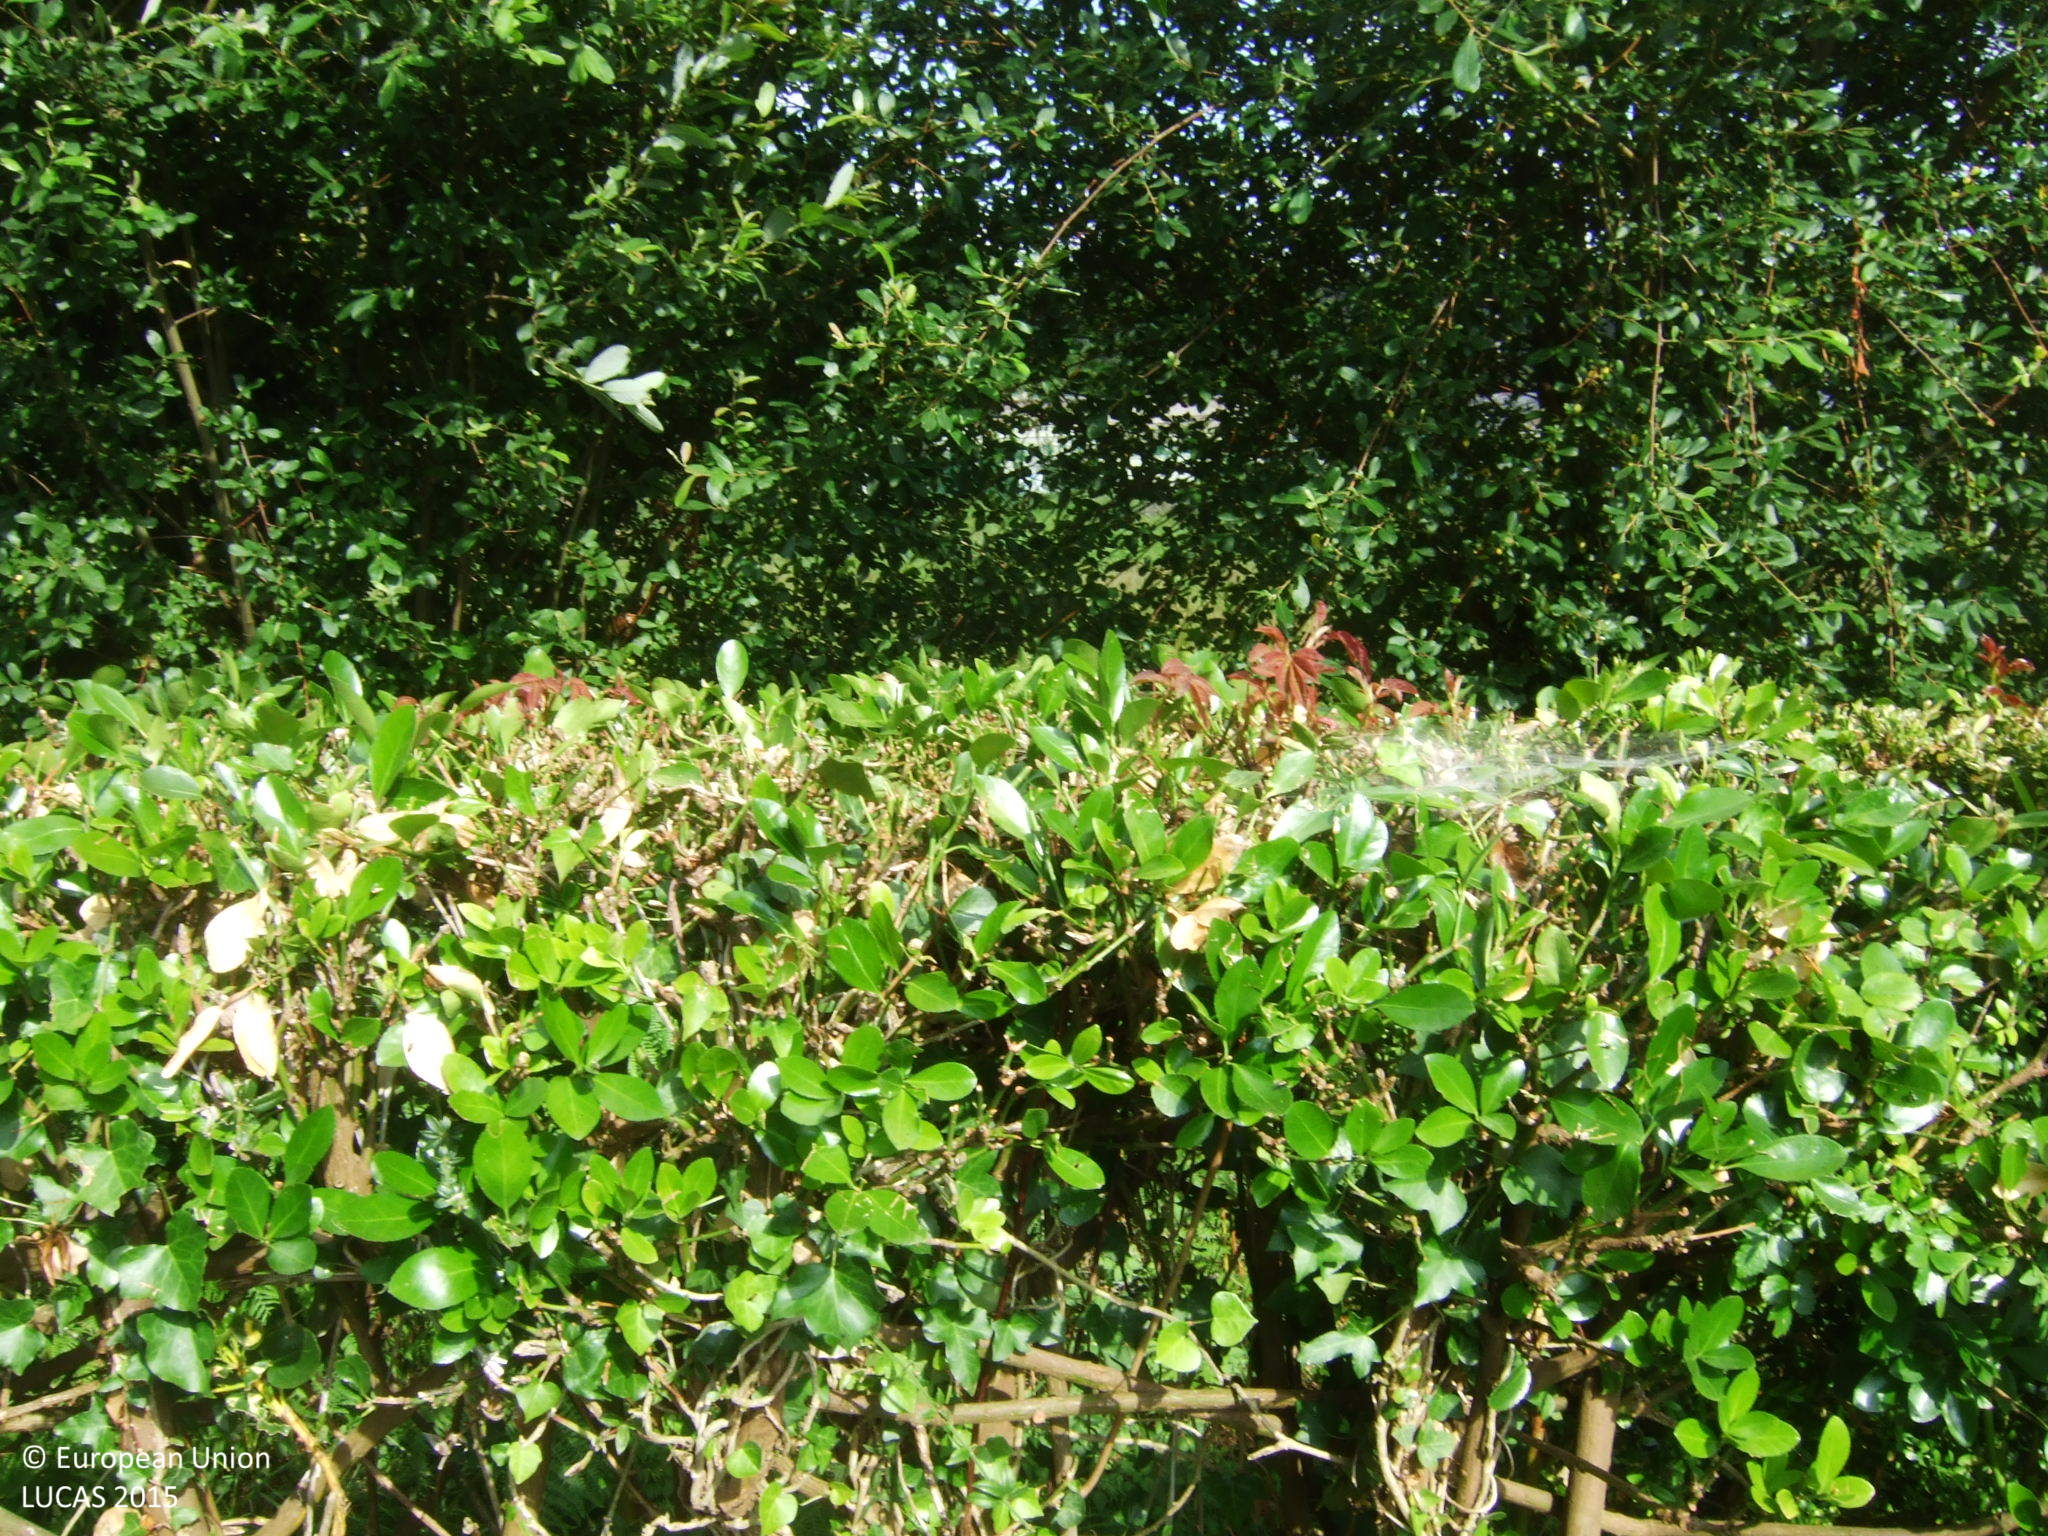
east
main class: Grassland
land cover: Grassland without tree/shrub cover
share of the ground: > 75 %
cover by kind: herbaceous plants 100 %
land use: Agriculture (excluding fallow land and kitchen gardens)
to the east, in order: Grassland without tree/shrub cover; Managed hedges; Groves; Grassland without tree/shrub cover; Fences; Grassland without tree/shrub cover; Potatoes; Other fresh vegetables; Managed hedges; Grassland without tree/shrub cover; Pine dominated coniferous woodland; Broadleaved woodland; Electric lines; Paved roads, cycling and walking lanes; Shrubland with sparse tree cover; Electric lines; Broadleaved woodland; Grassland without tree/shrub cover
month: June
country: ES
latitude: 43.6945
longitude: -7.6189
